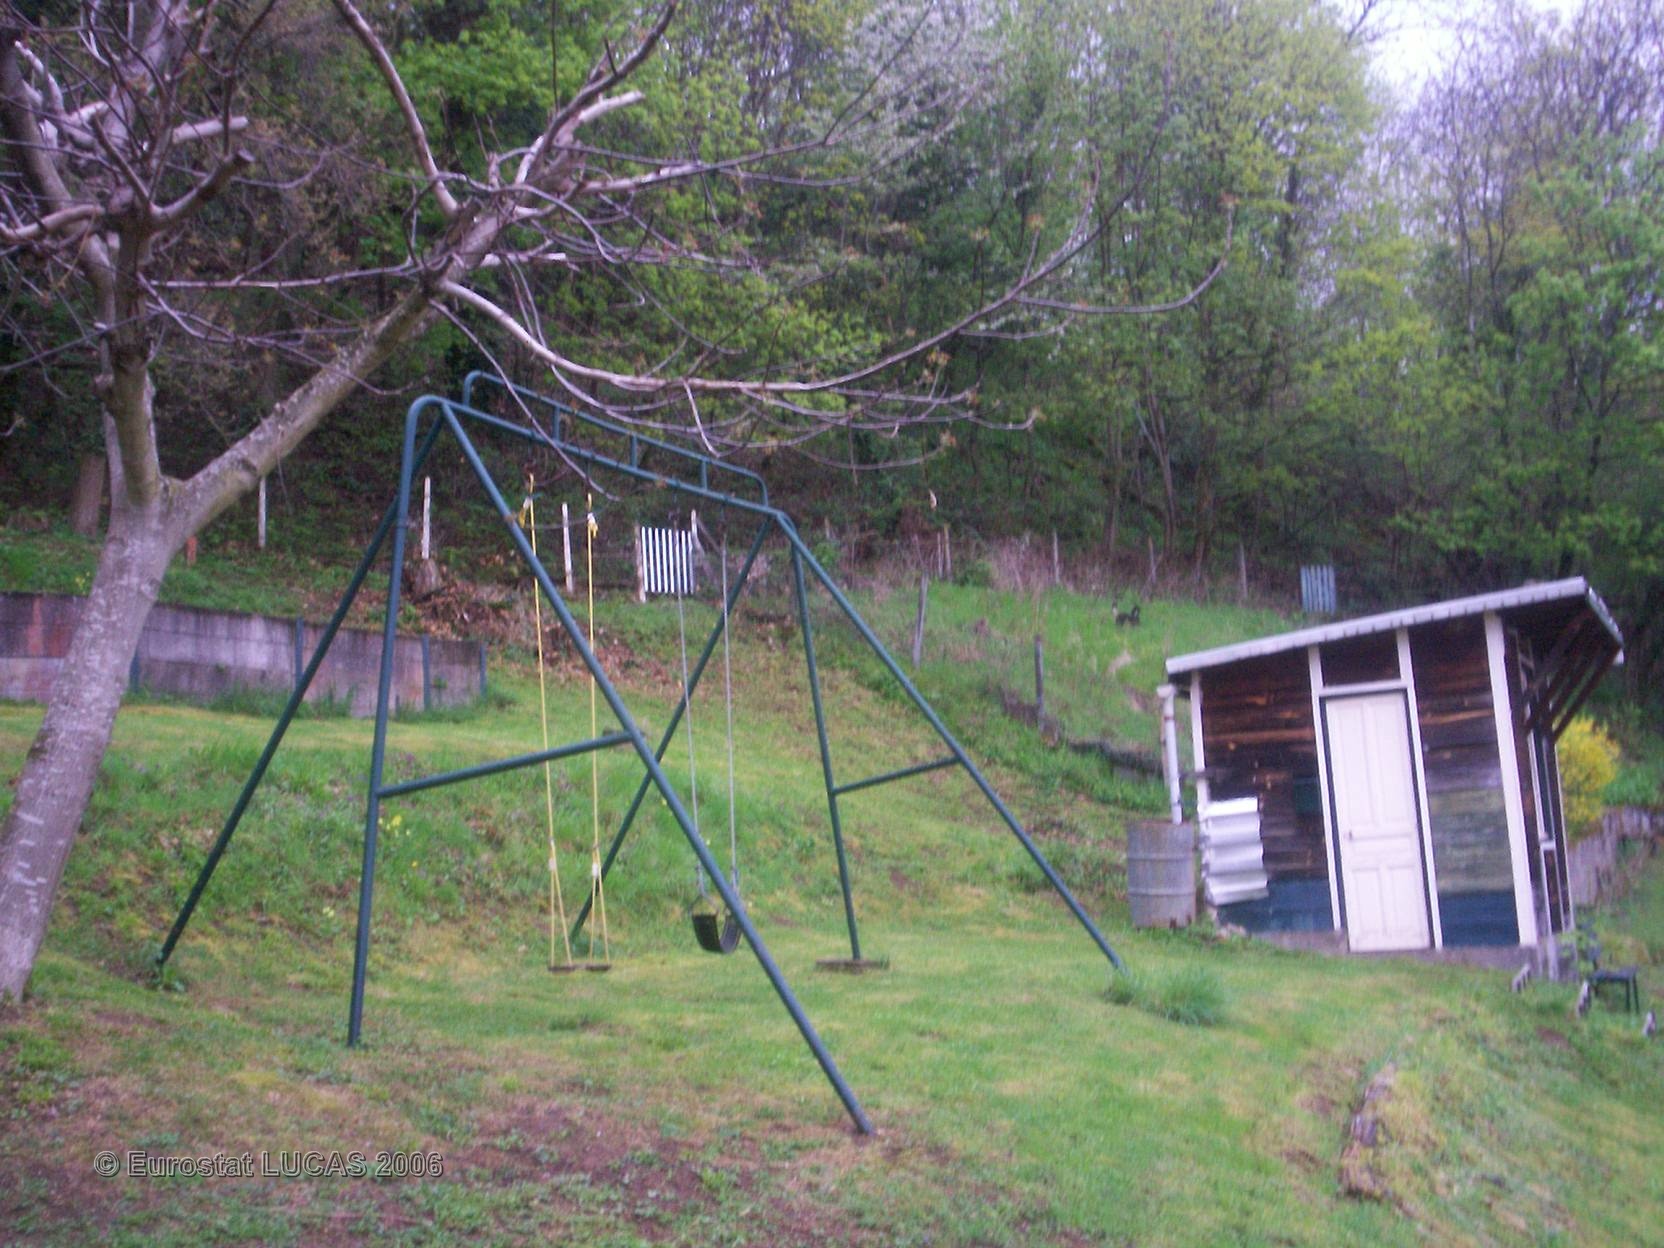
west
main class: Grassland
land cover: Grassland with sparse tree/shrub cover
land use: Residential
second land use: Kitchen garden
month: April
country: FR
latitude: 45.7631
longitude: 3.0436
